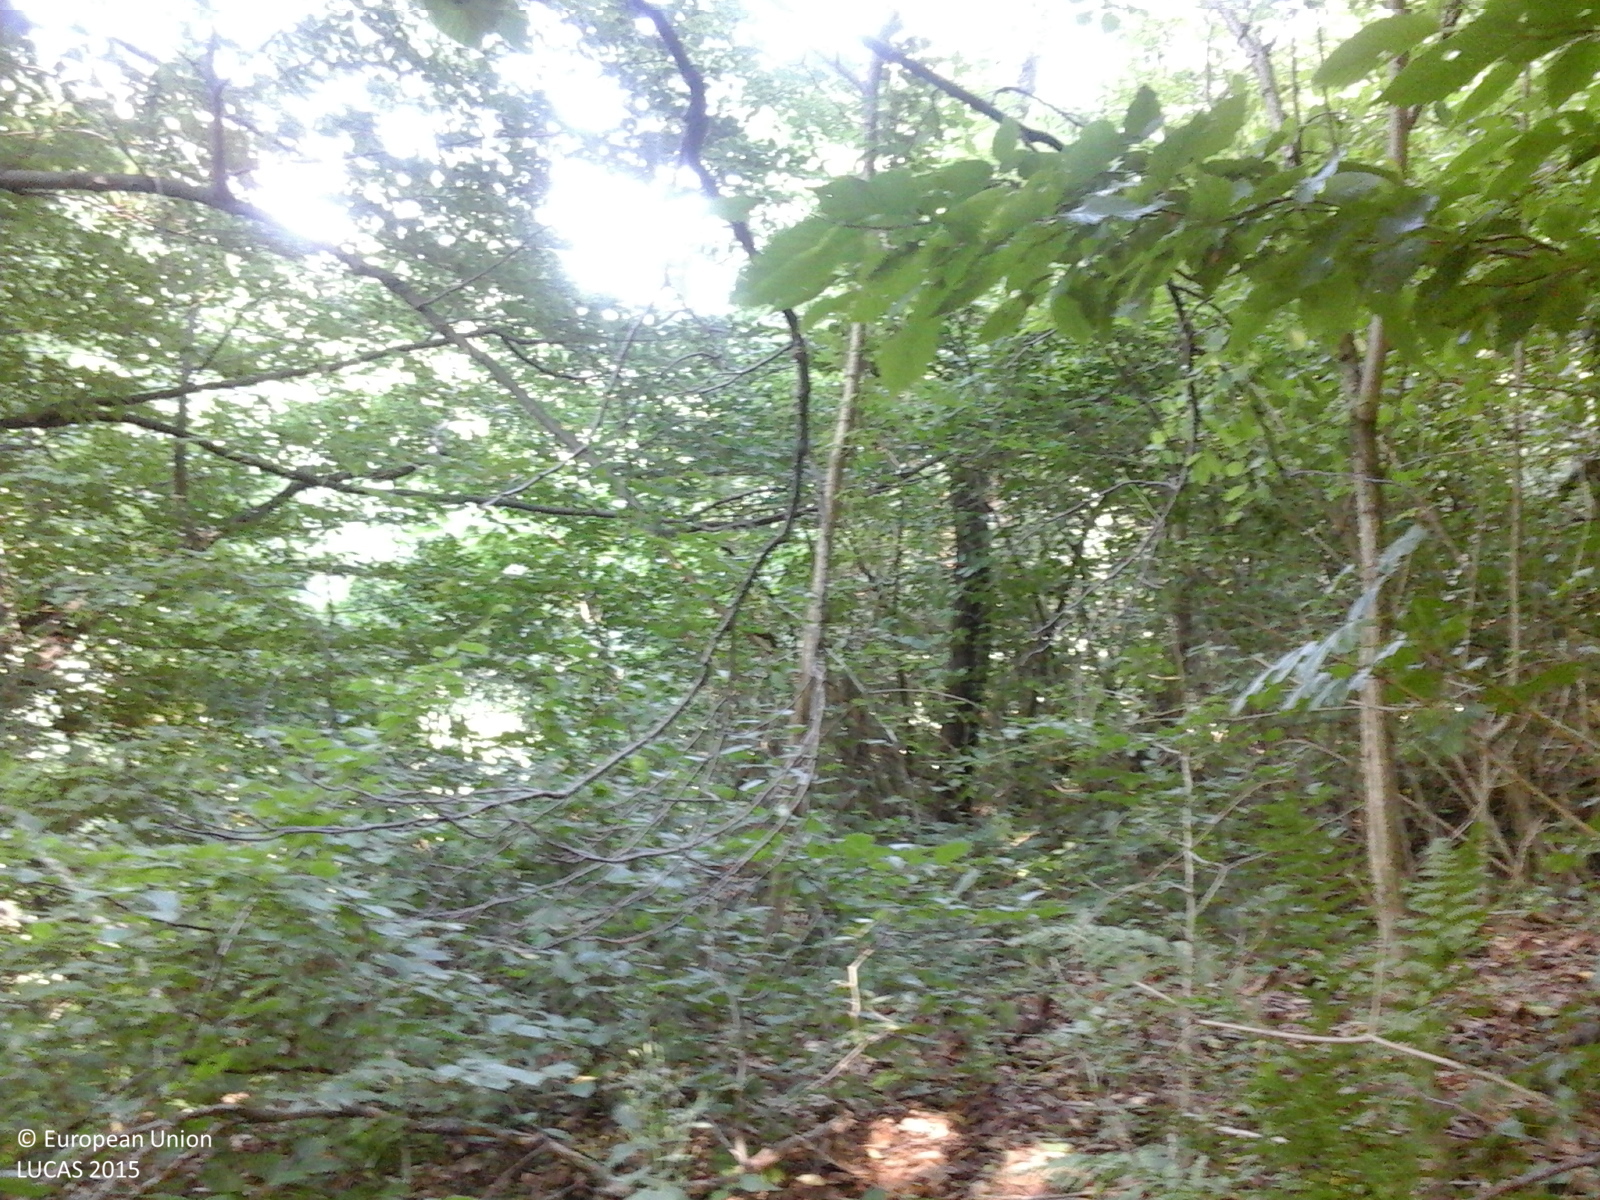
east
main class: Woodland
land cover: Broadleaved woodland
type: beech forest
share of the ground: > 75 %
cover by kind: broadleaved forest trees 100 %
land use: Forestry
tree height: > 5 m
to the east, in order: Broadleaved woodland; Tracks; Broadleaved woodland; Artificial constructions in urban areas; Broadleaved woodland; Grassland with sparse tree/shrub cover
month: July
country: RO
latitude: 45.0619
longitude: 24.7748
